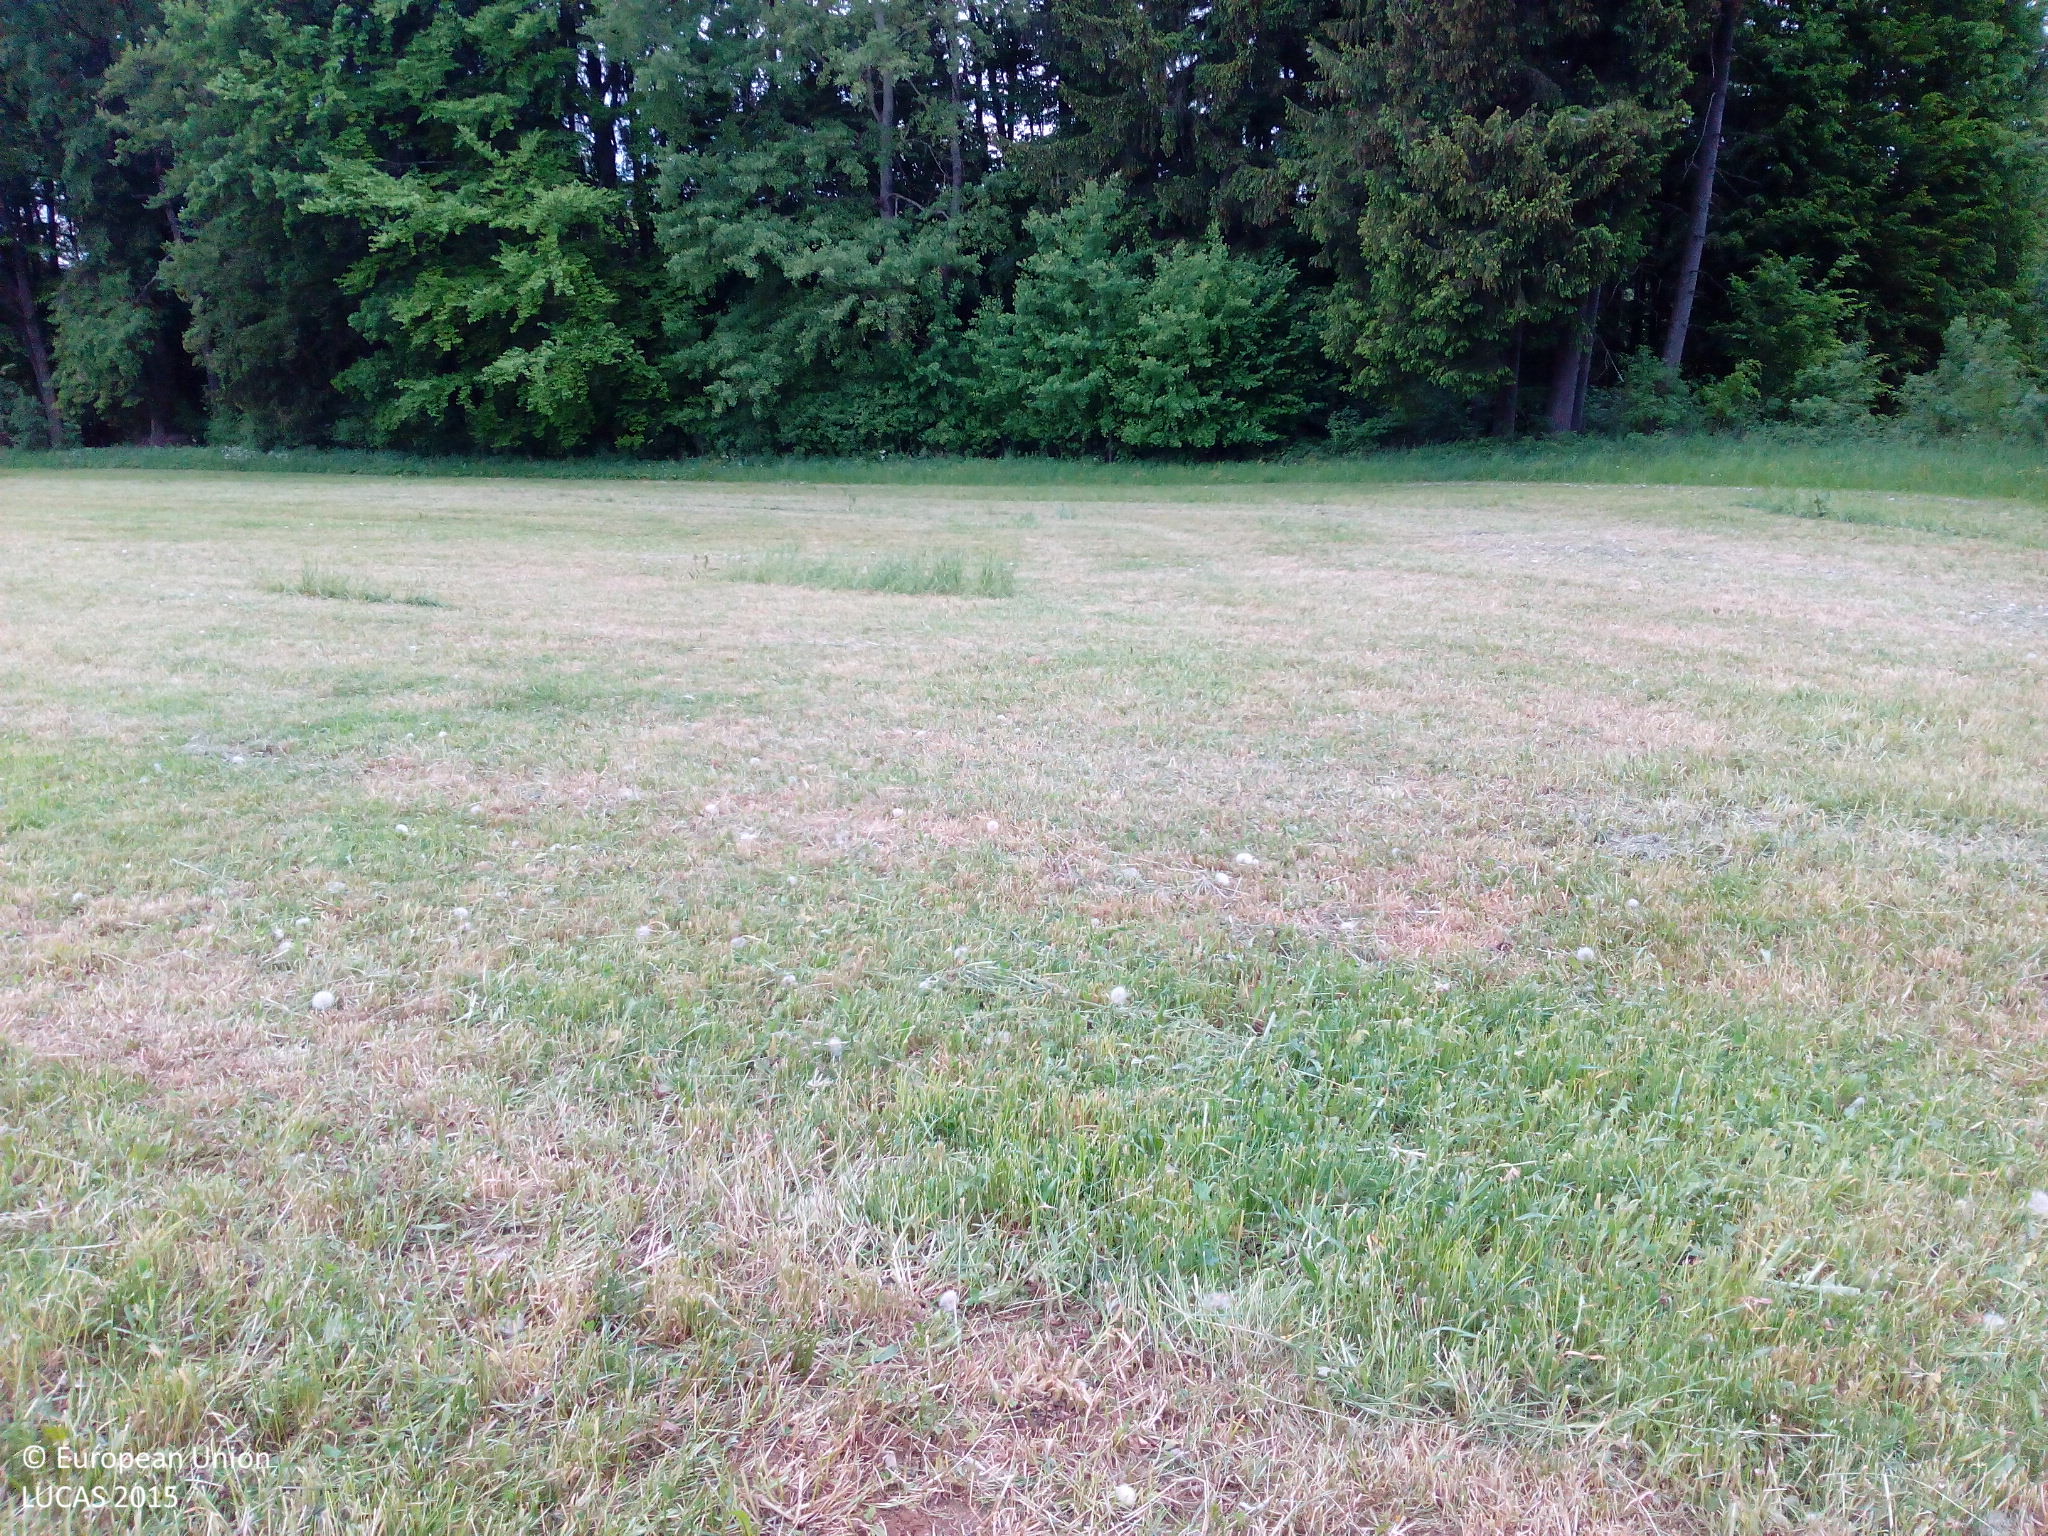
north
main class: Grassland
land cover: Grassland without tree/shrub cover
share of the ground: > 75 %
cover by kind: herbaceous plants 90 %, lichens and mosses 5 %, unconsolidated bare surface 5 %
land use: Agriculture (excluding fallow land and kitchen gardens)
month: May
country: DE
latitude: 49.2207
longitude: 11.5235
